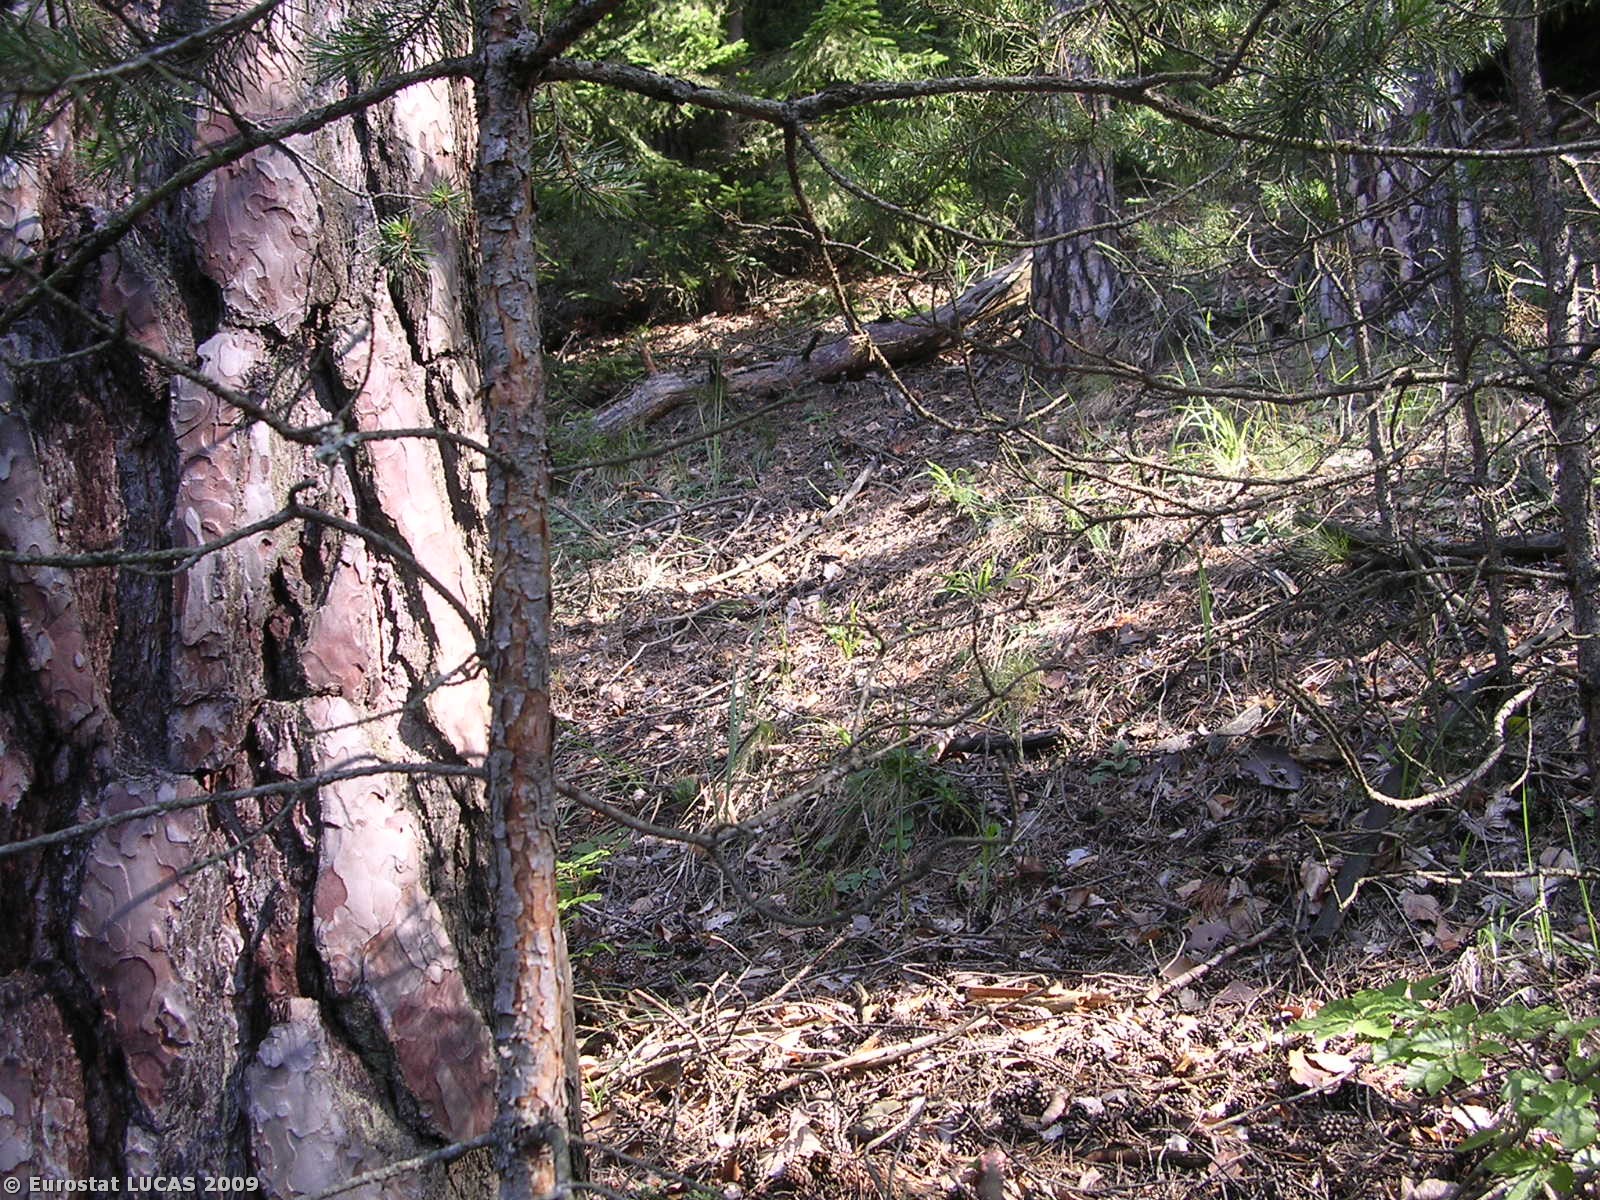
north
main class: Woodland
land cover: Coniferous woodland
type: hemiboreal forest and nemoral coniferous forest and mixed broadleaved-coniferous forest
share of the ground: > 75 %
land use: Forestry
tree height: > 5 m
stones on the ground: < 10 %
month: July
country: CZ
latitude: 50.5987
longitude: 14.9617
